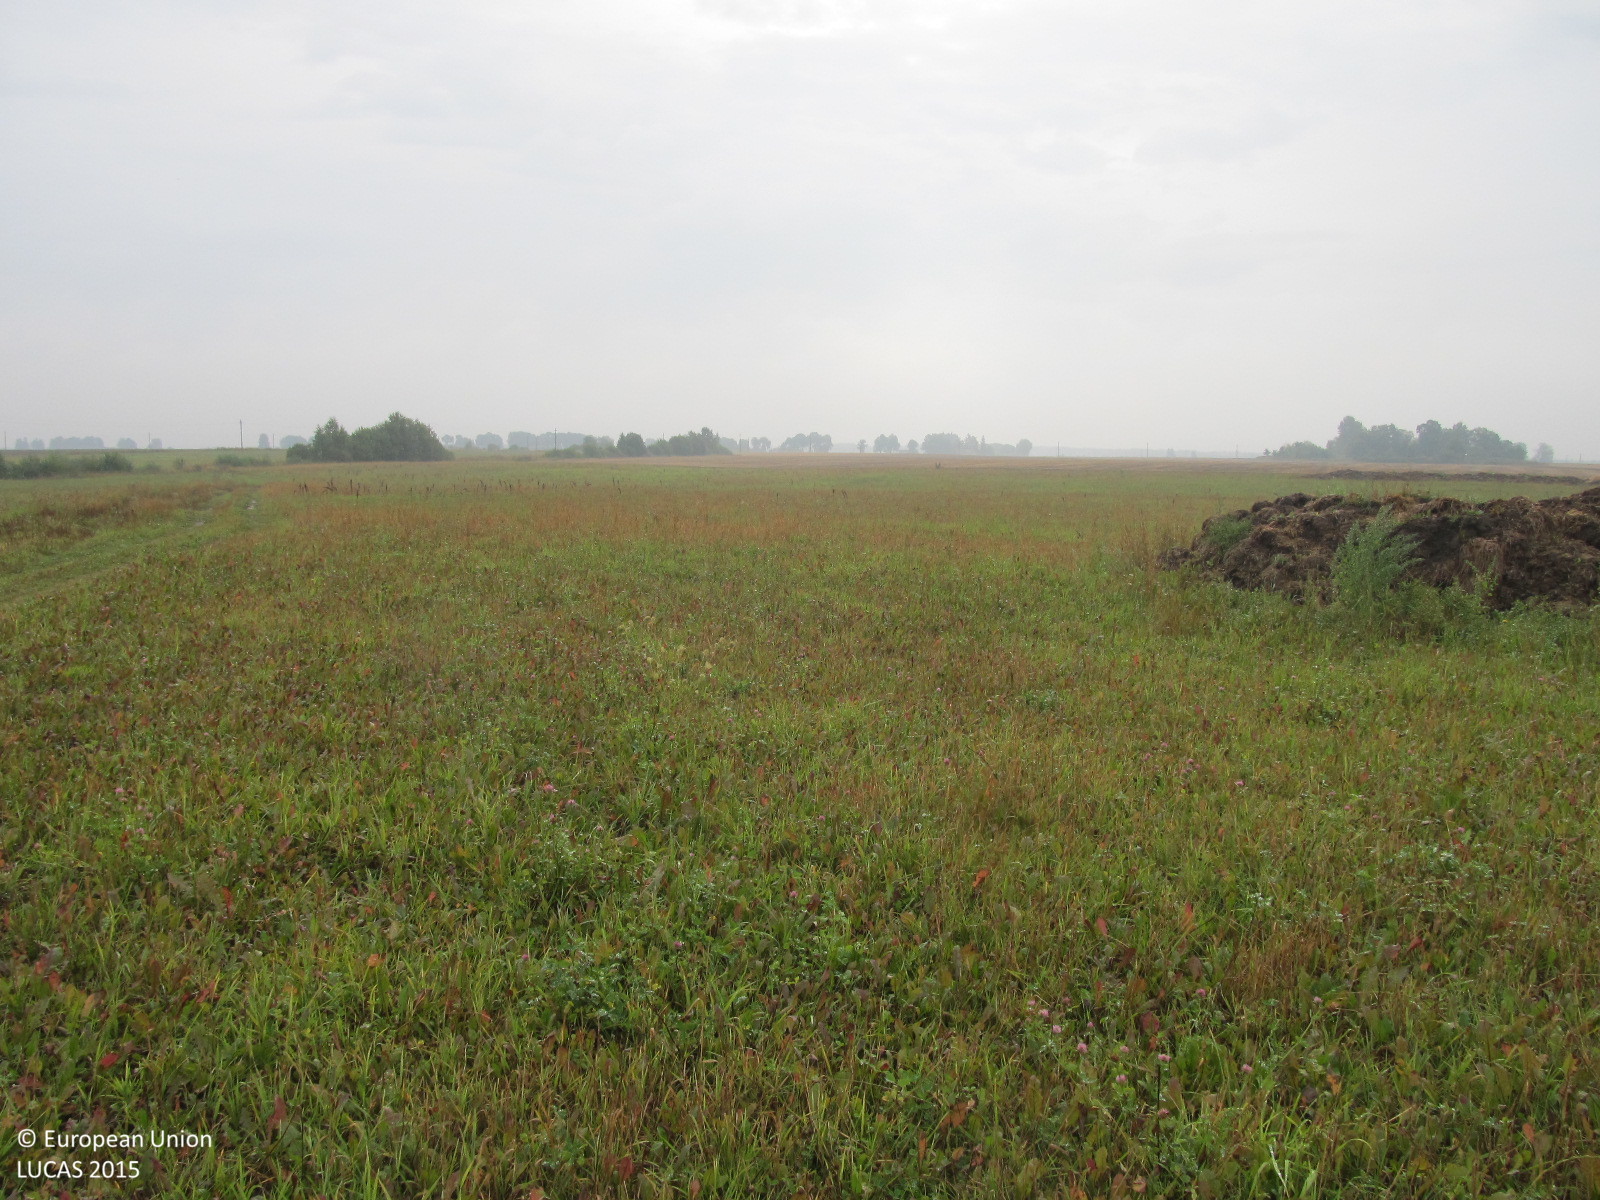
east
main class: Grassland
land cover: Grassland without tree/shrub cover
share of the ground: > 75 %
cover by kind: herbaceous plants 100 %
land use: Agriculture (excluding fallow land and kitchen gardens)
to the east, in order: Grassland without tree/shrub cover; Tracks; Grassland without tree/shrub cover; Other bare soil
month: September
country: LT
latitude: 56.0747
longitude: 23.1314
